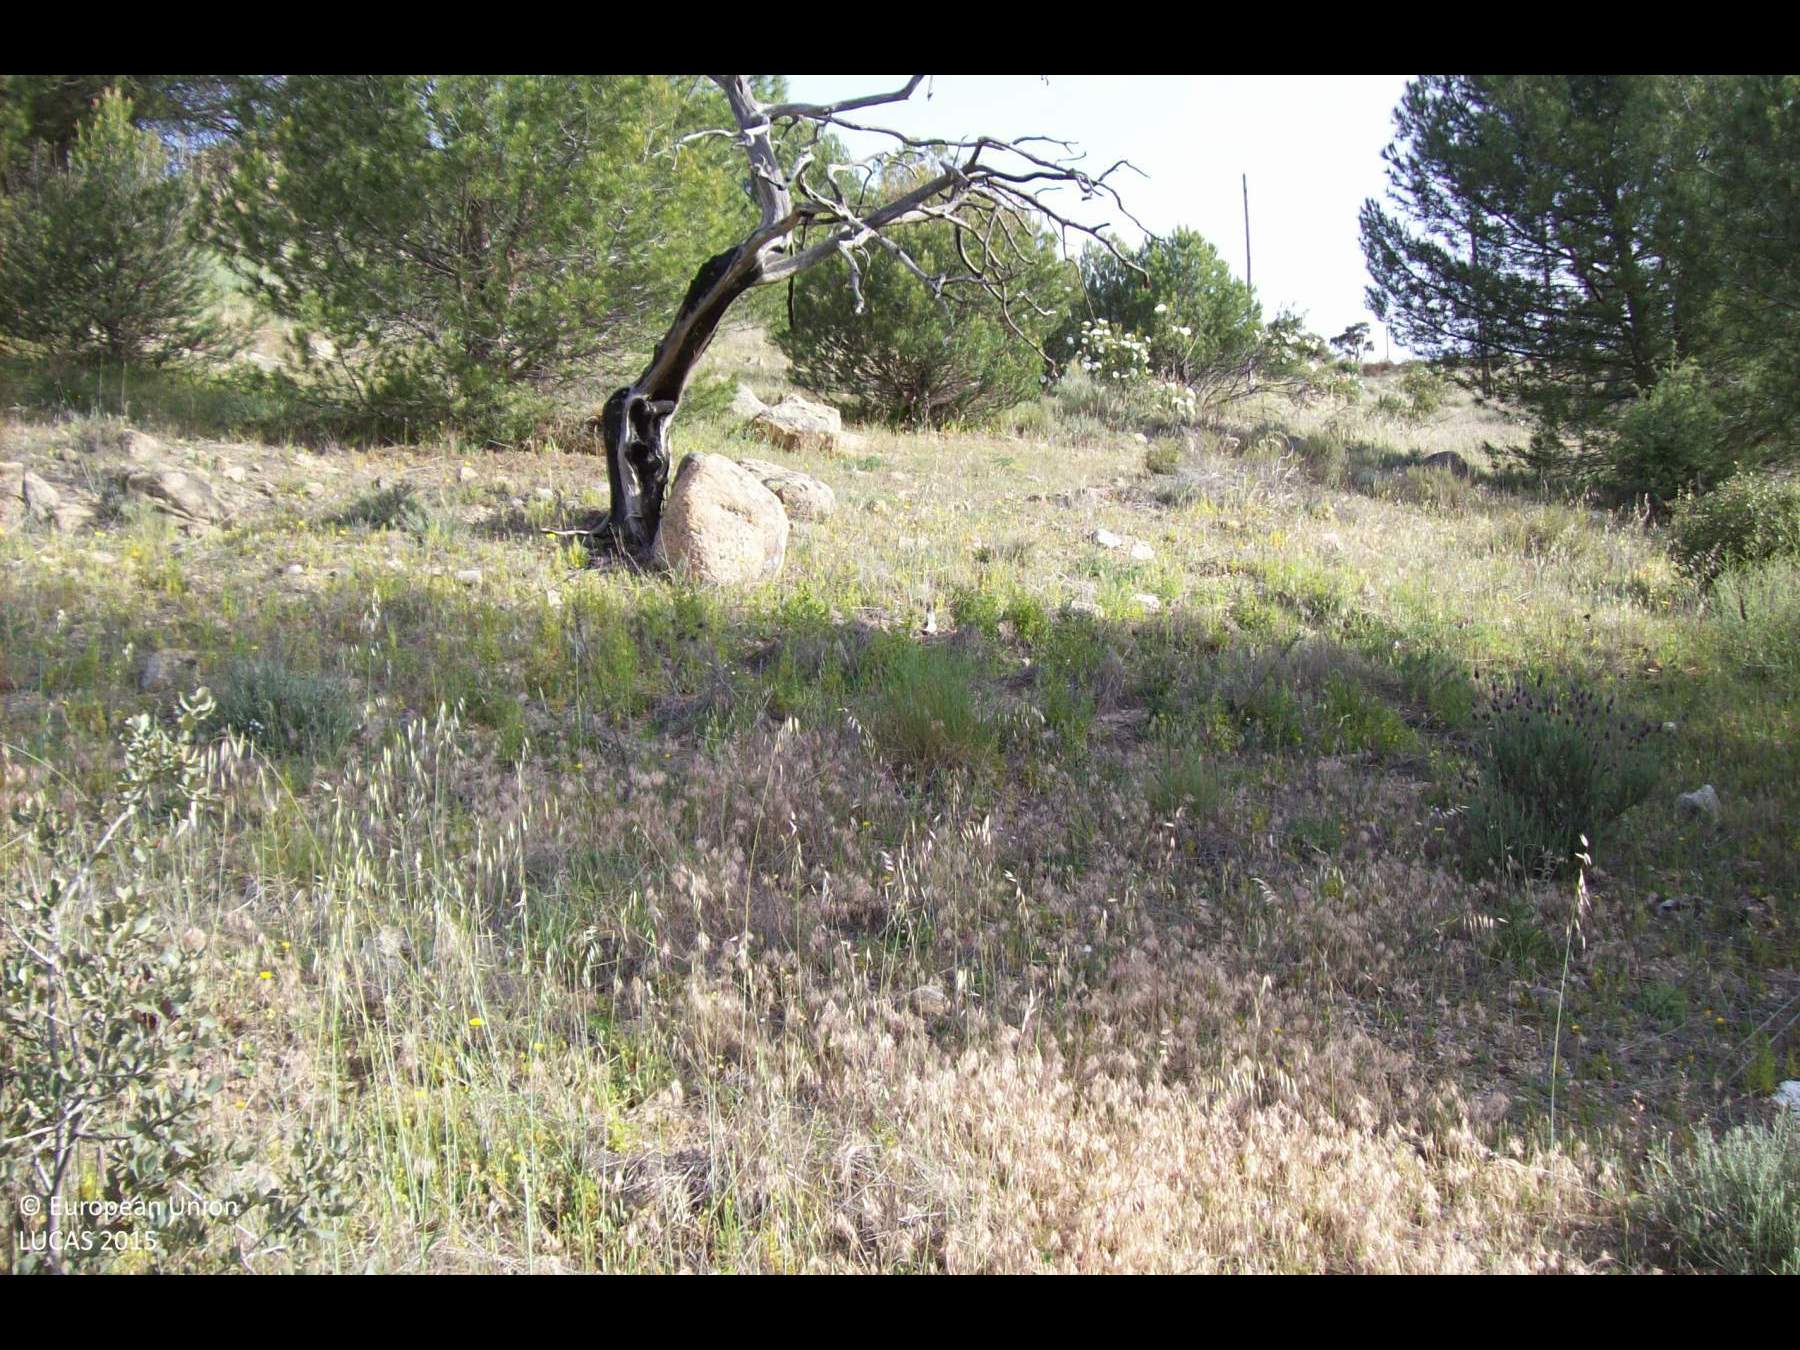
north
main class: Grassland
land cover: Grassland with sparse tree/shrub cover
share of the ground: > 75 %
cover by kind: herbaceous plants 85 %, coniferous forest trees 5 %, shrubs 5 %, consolidated bare surface 5 %
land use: Semi-natural and natural areas not in use
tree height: < 5 m
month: April
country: ES
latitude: 40.5494
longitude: -3.9411
